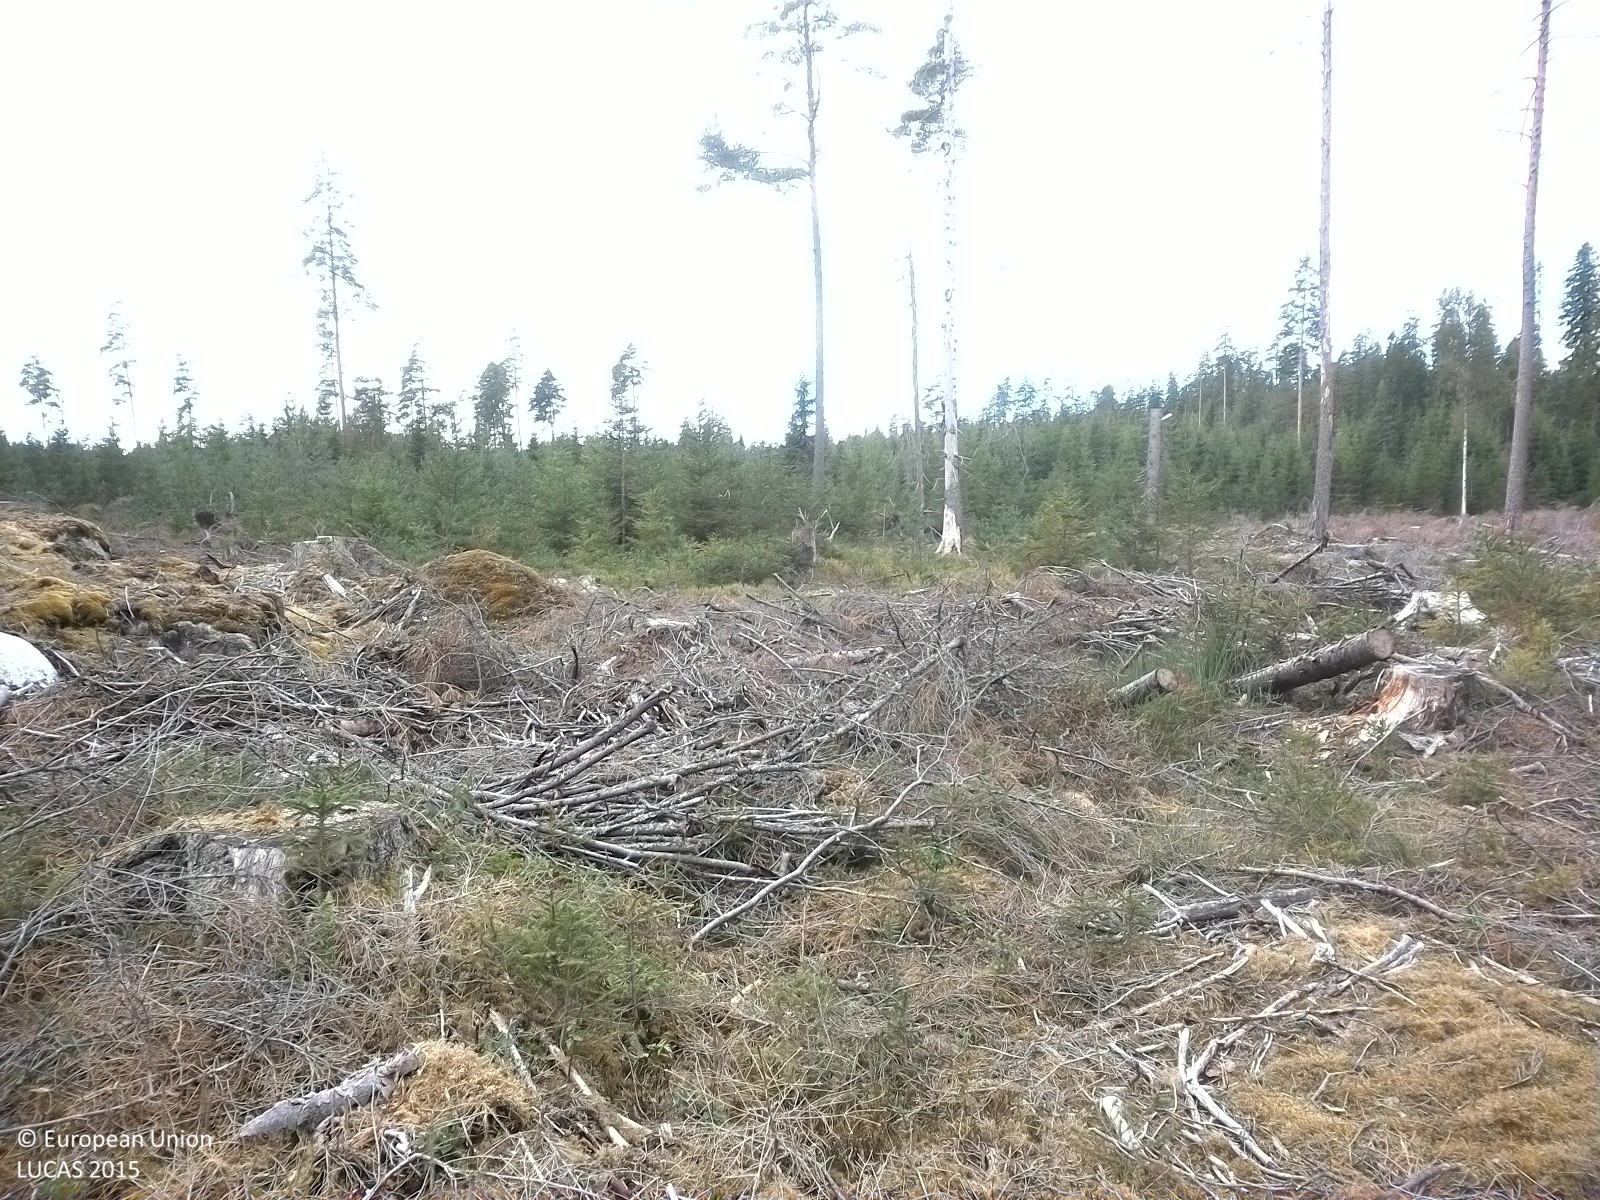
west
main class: Grassland
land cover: Spontaneously vegetated surfaces
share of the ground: 50 - 75 %
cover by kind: herbaceous plants 55 %, lichens and mosses 25 %, unconsolidated bare surface 20 %
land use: Forestry
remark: Clear cut
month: August
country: SE
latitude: 58.9904
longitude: 15.5093
